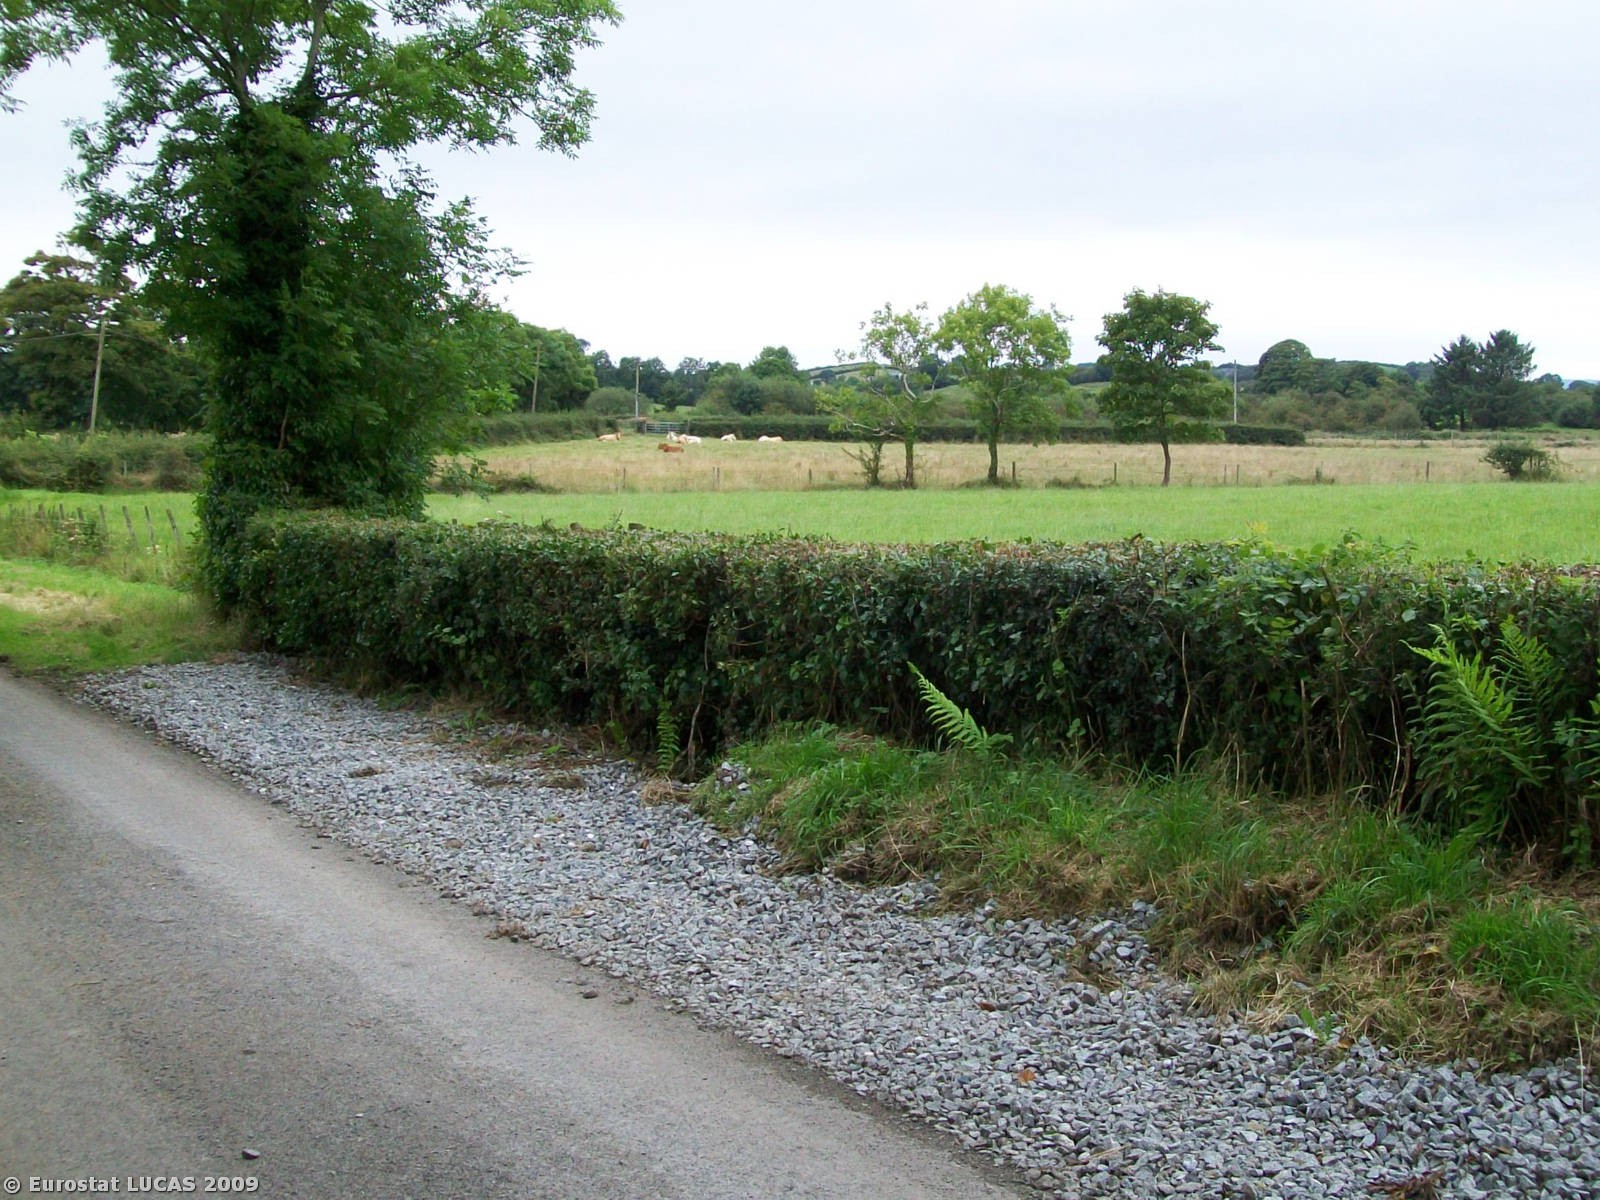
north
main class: Grassland
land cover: Grassland without tree/shrub cover
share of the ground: > 75 %
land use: Agriculture (excluding fallow land and kitchen gardens)
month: August
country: GB
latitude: 54.1364
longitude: -6.6129
